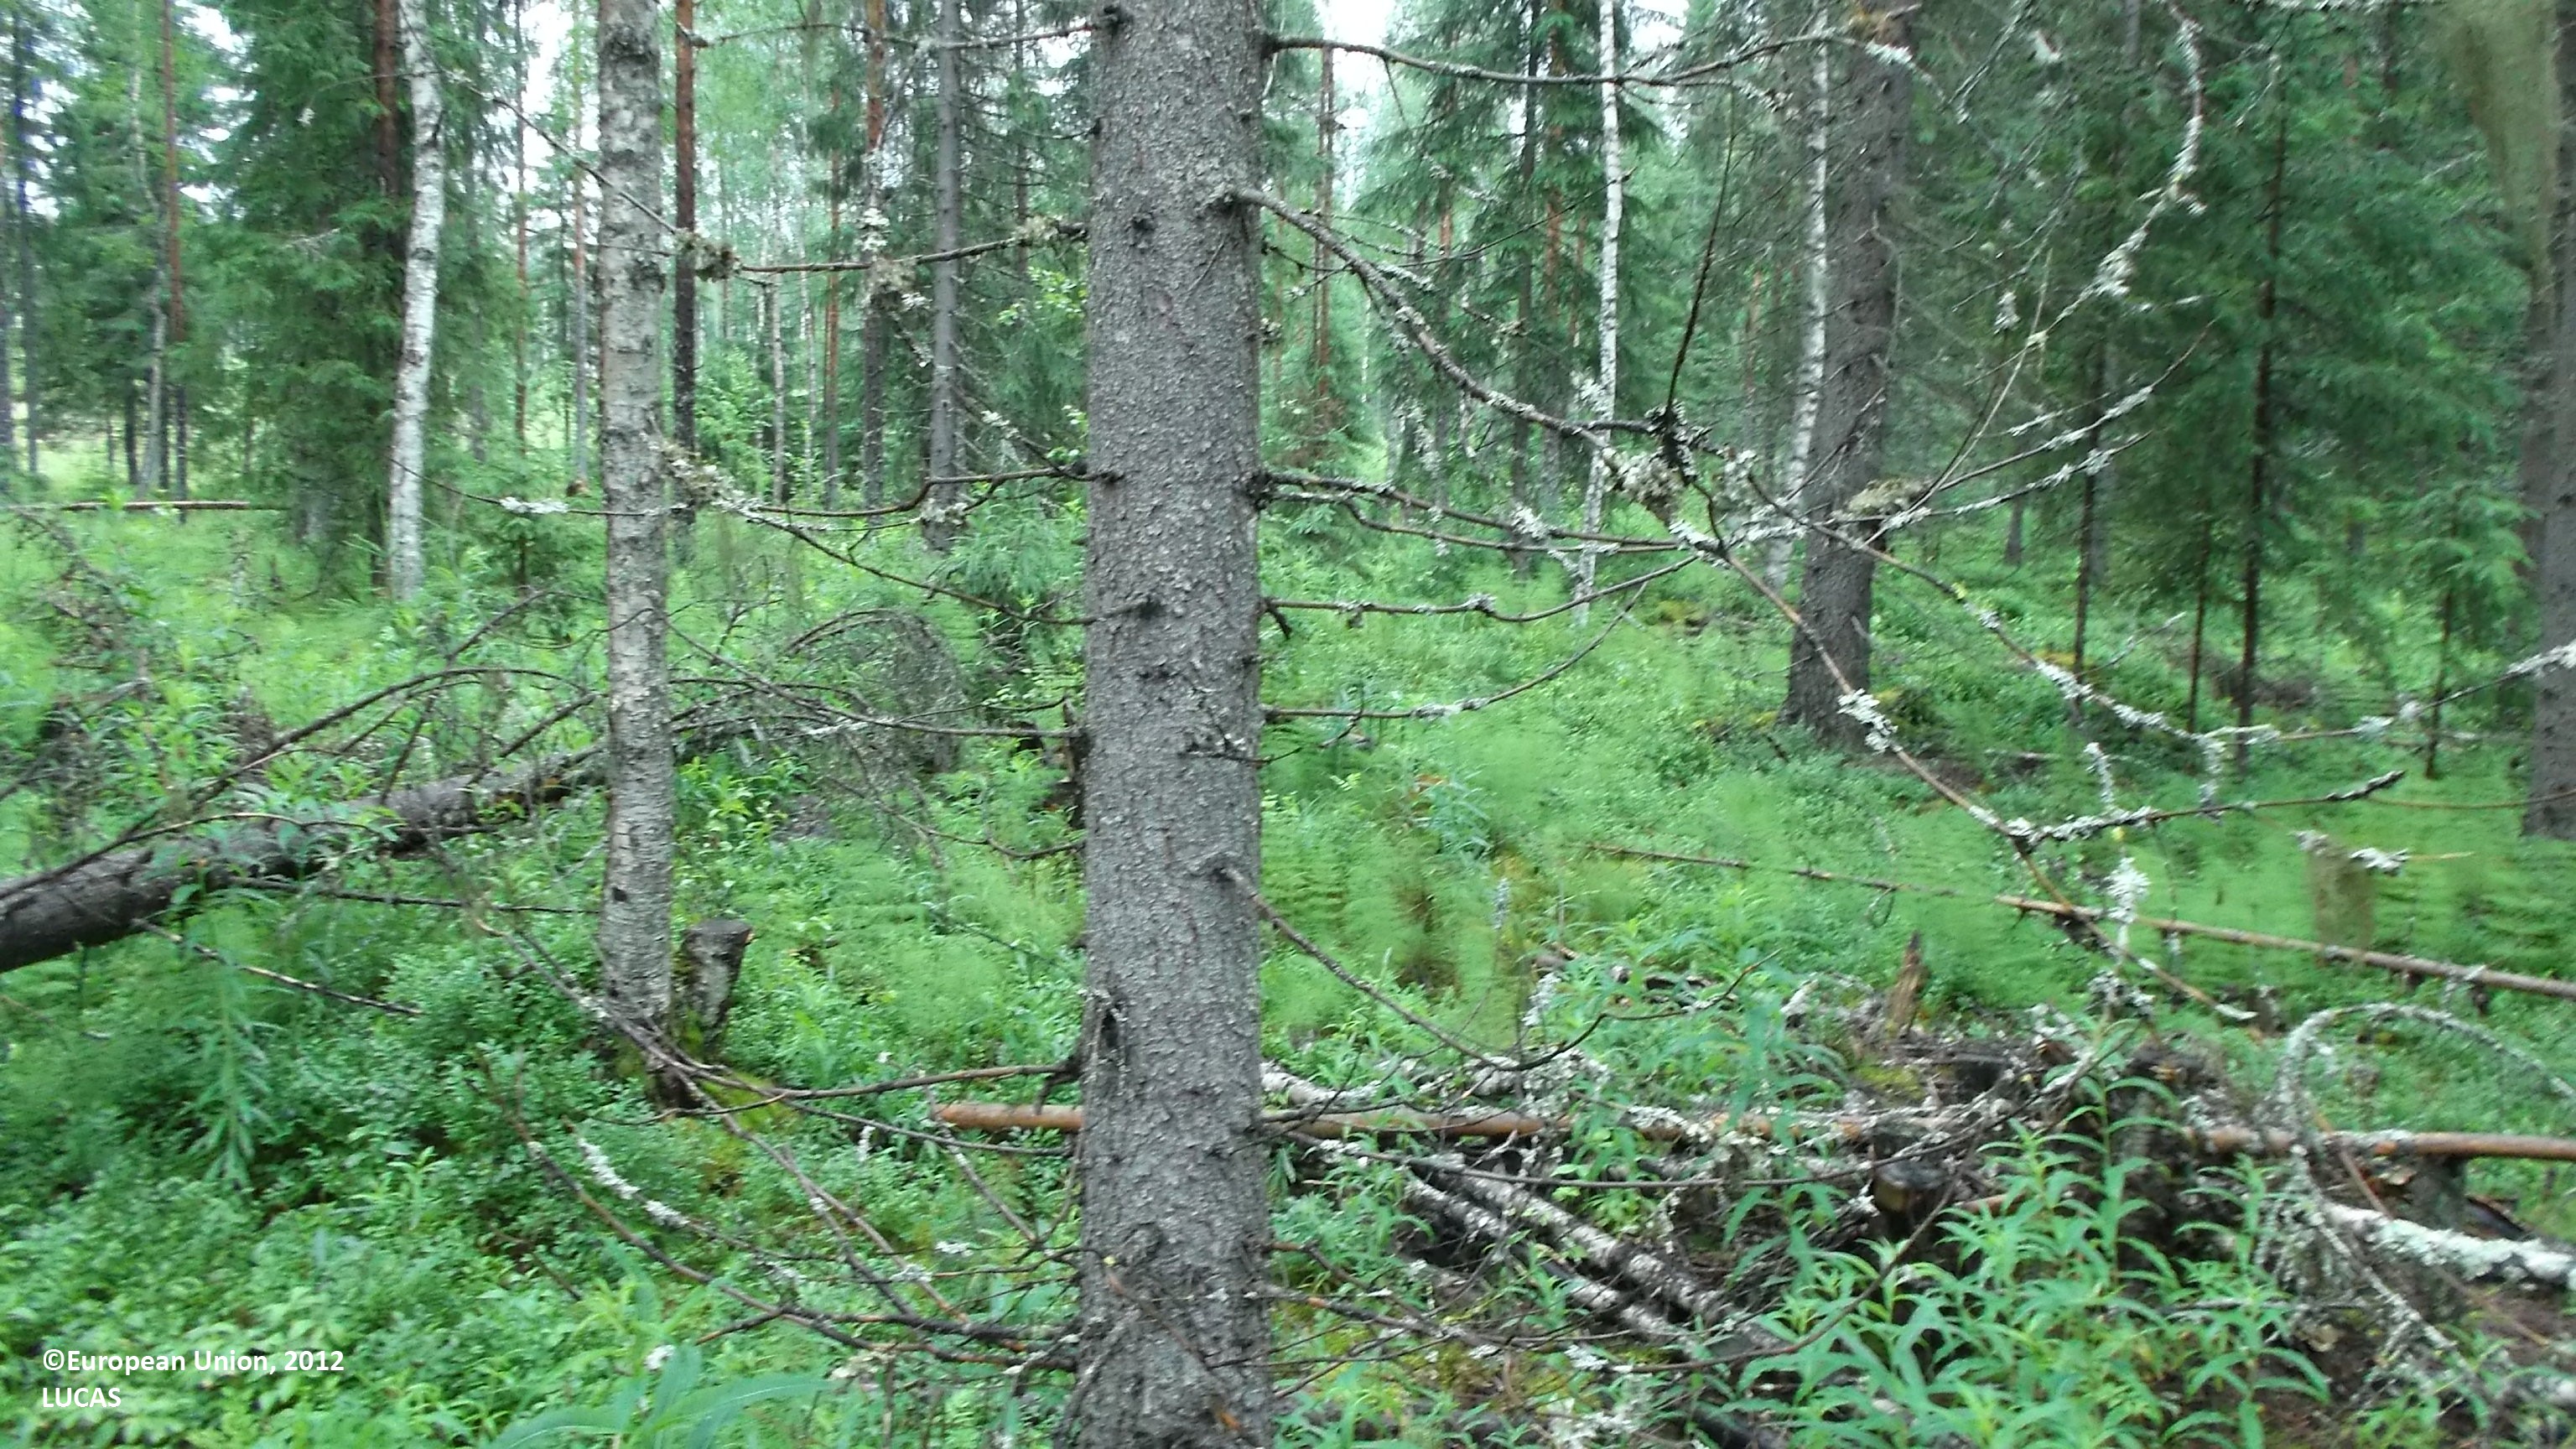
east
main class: Woodland
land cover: Other mixed woodland
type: boreal forest
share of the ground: 50 - 75 %
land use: Forestry
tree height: > 5 m
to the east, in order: Other mixed woodland; Spruce dominated mixed woodland; Spruce dominated coniferous woodland; Ditches and canals; Spruce dominated coniferous woodland; Paved roads, cycling and walking lanes; Other mixed woodland; Tracks; Spruce dominated mixed woodland; Spruce dominated coniferous woodland
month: July
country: FI
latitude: 63.4316
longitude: 23.9173
